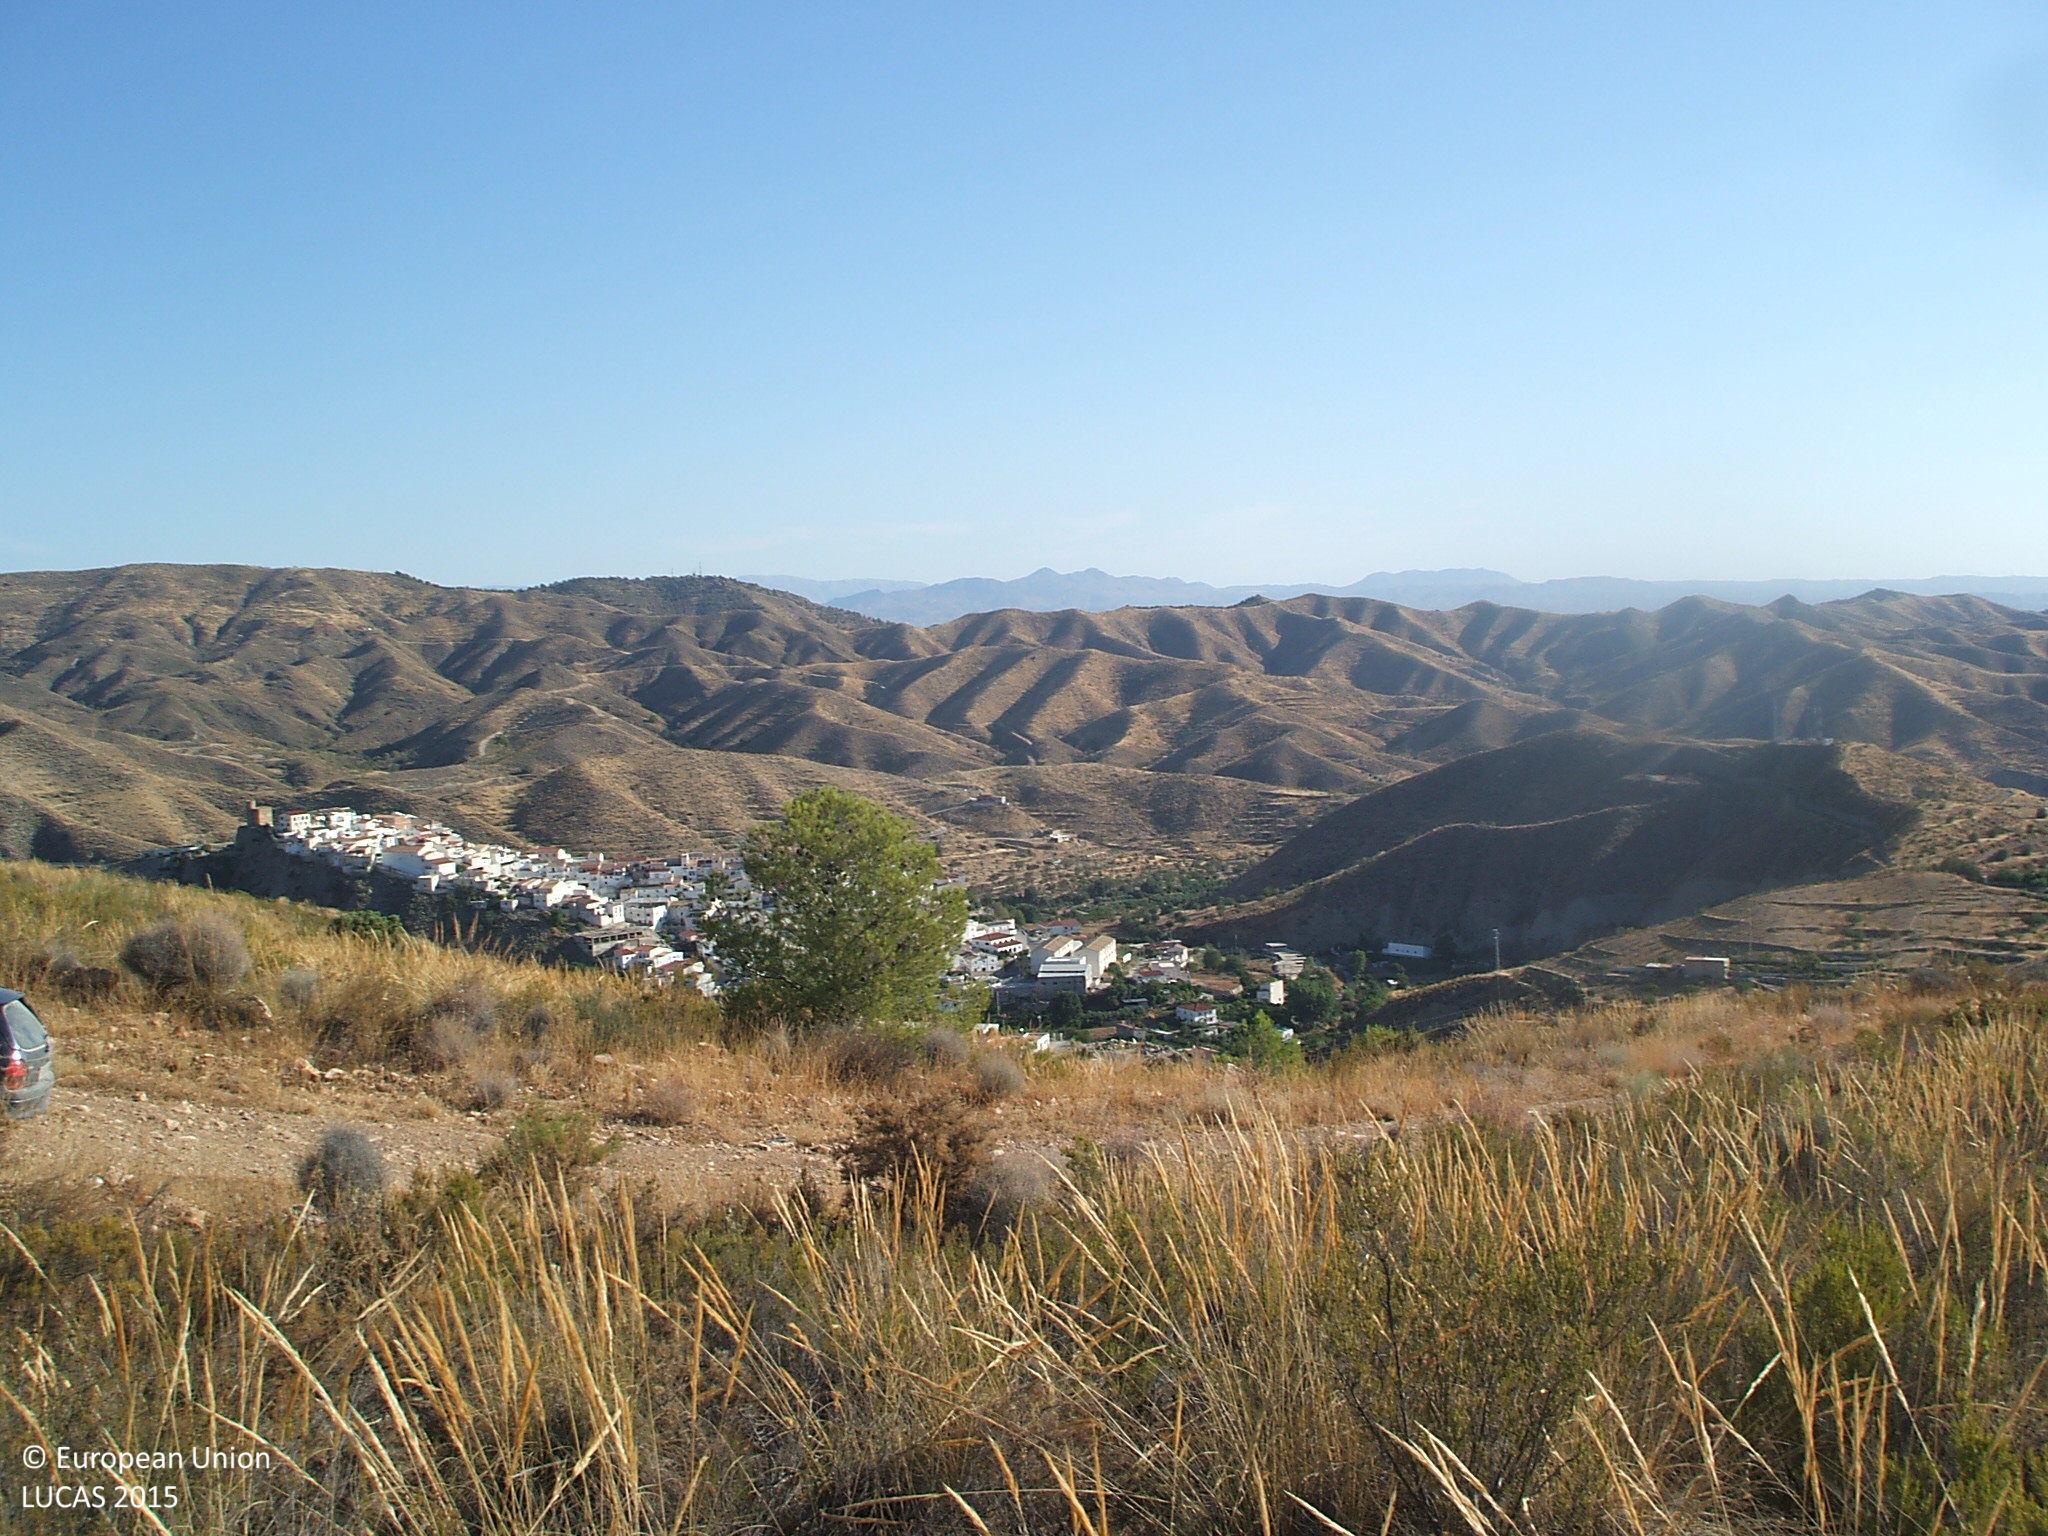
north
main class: Shrubland
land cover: Shrubland without tree cover
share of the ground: 25 - 50 %
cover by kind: shrubs 40 %, herbaceous plants 40 %, consolidated bare surface 20 %
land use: Semi-natural and natural areas not in use
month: July
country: ES
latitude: 37.2863
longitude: -2.2184
